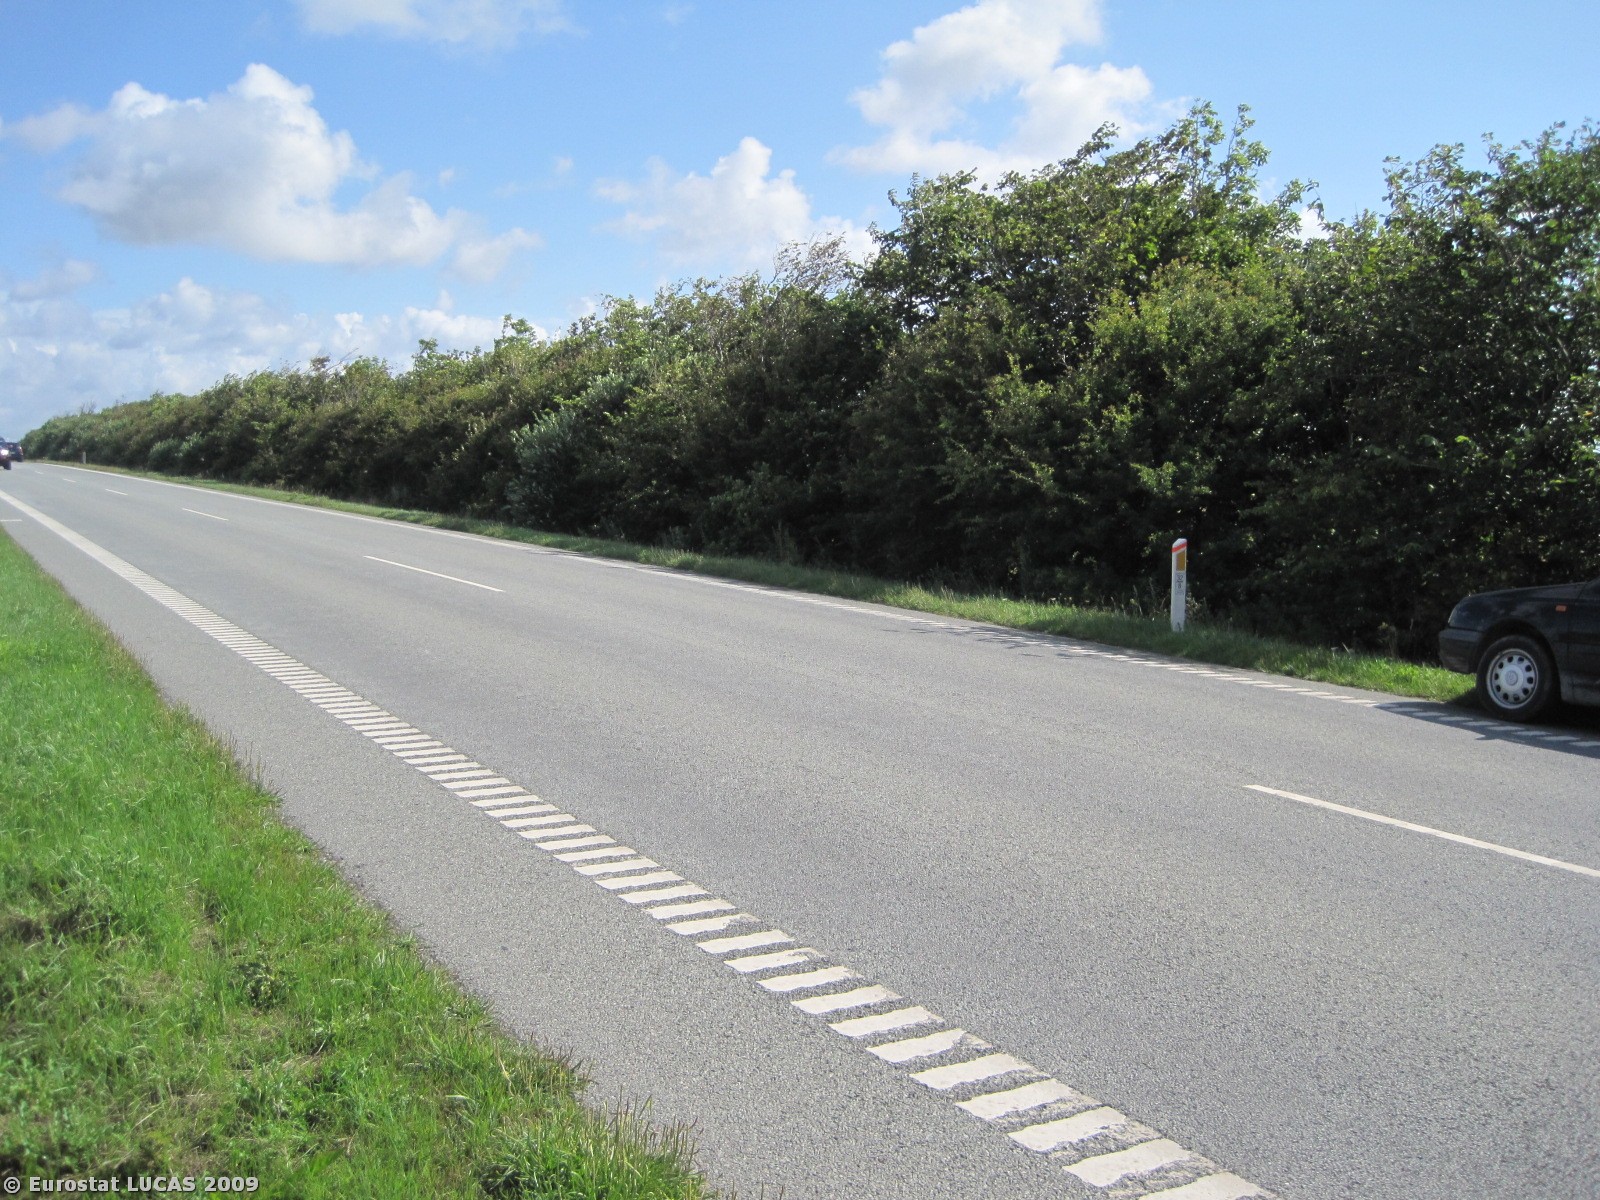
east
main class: Grassland
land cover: Grassland without tree/shrub cover
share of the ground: > 75 %
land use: Agriculture (excluding fallow land and kitchen gardens)
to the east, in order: Grassland without tree/shrub cover; Fences; Broadleaved woodland; Rye; Grass margins; Paved roads, cycling and walking lanes; Grass margins; Ditches and canals; Grass margins; Broadleaved woodland; Grass margins; Common wheat; Broadleaved woodland; Oats
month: July
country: DK
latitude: 56.7174
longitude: 8.4172
